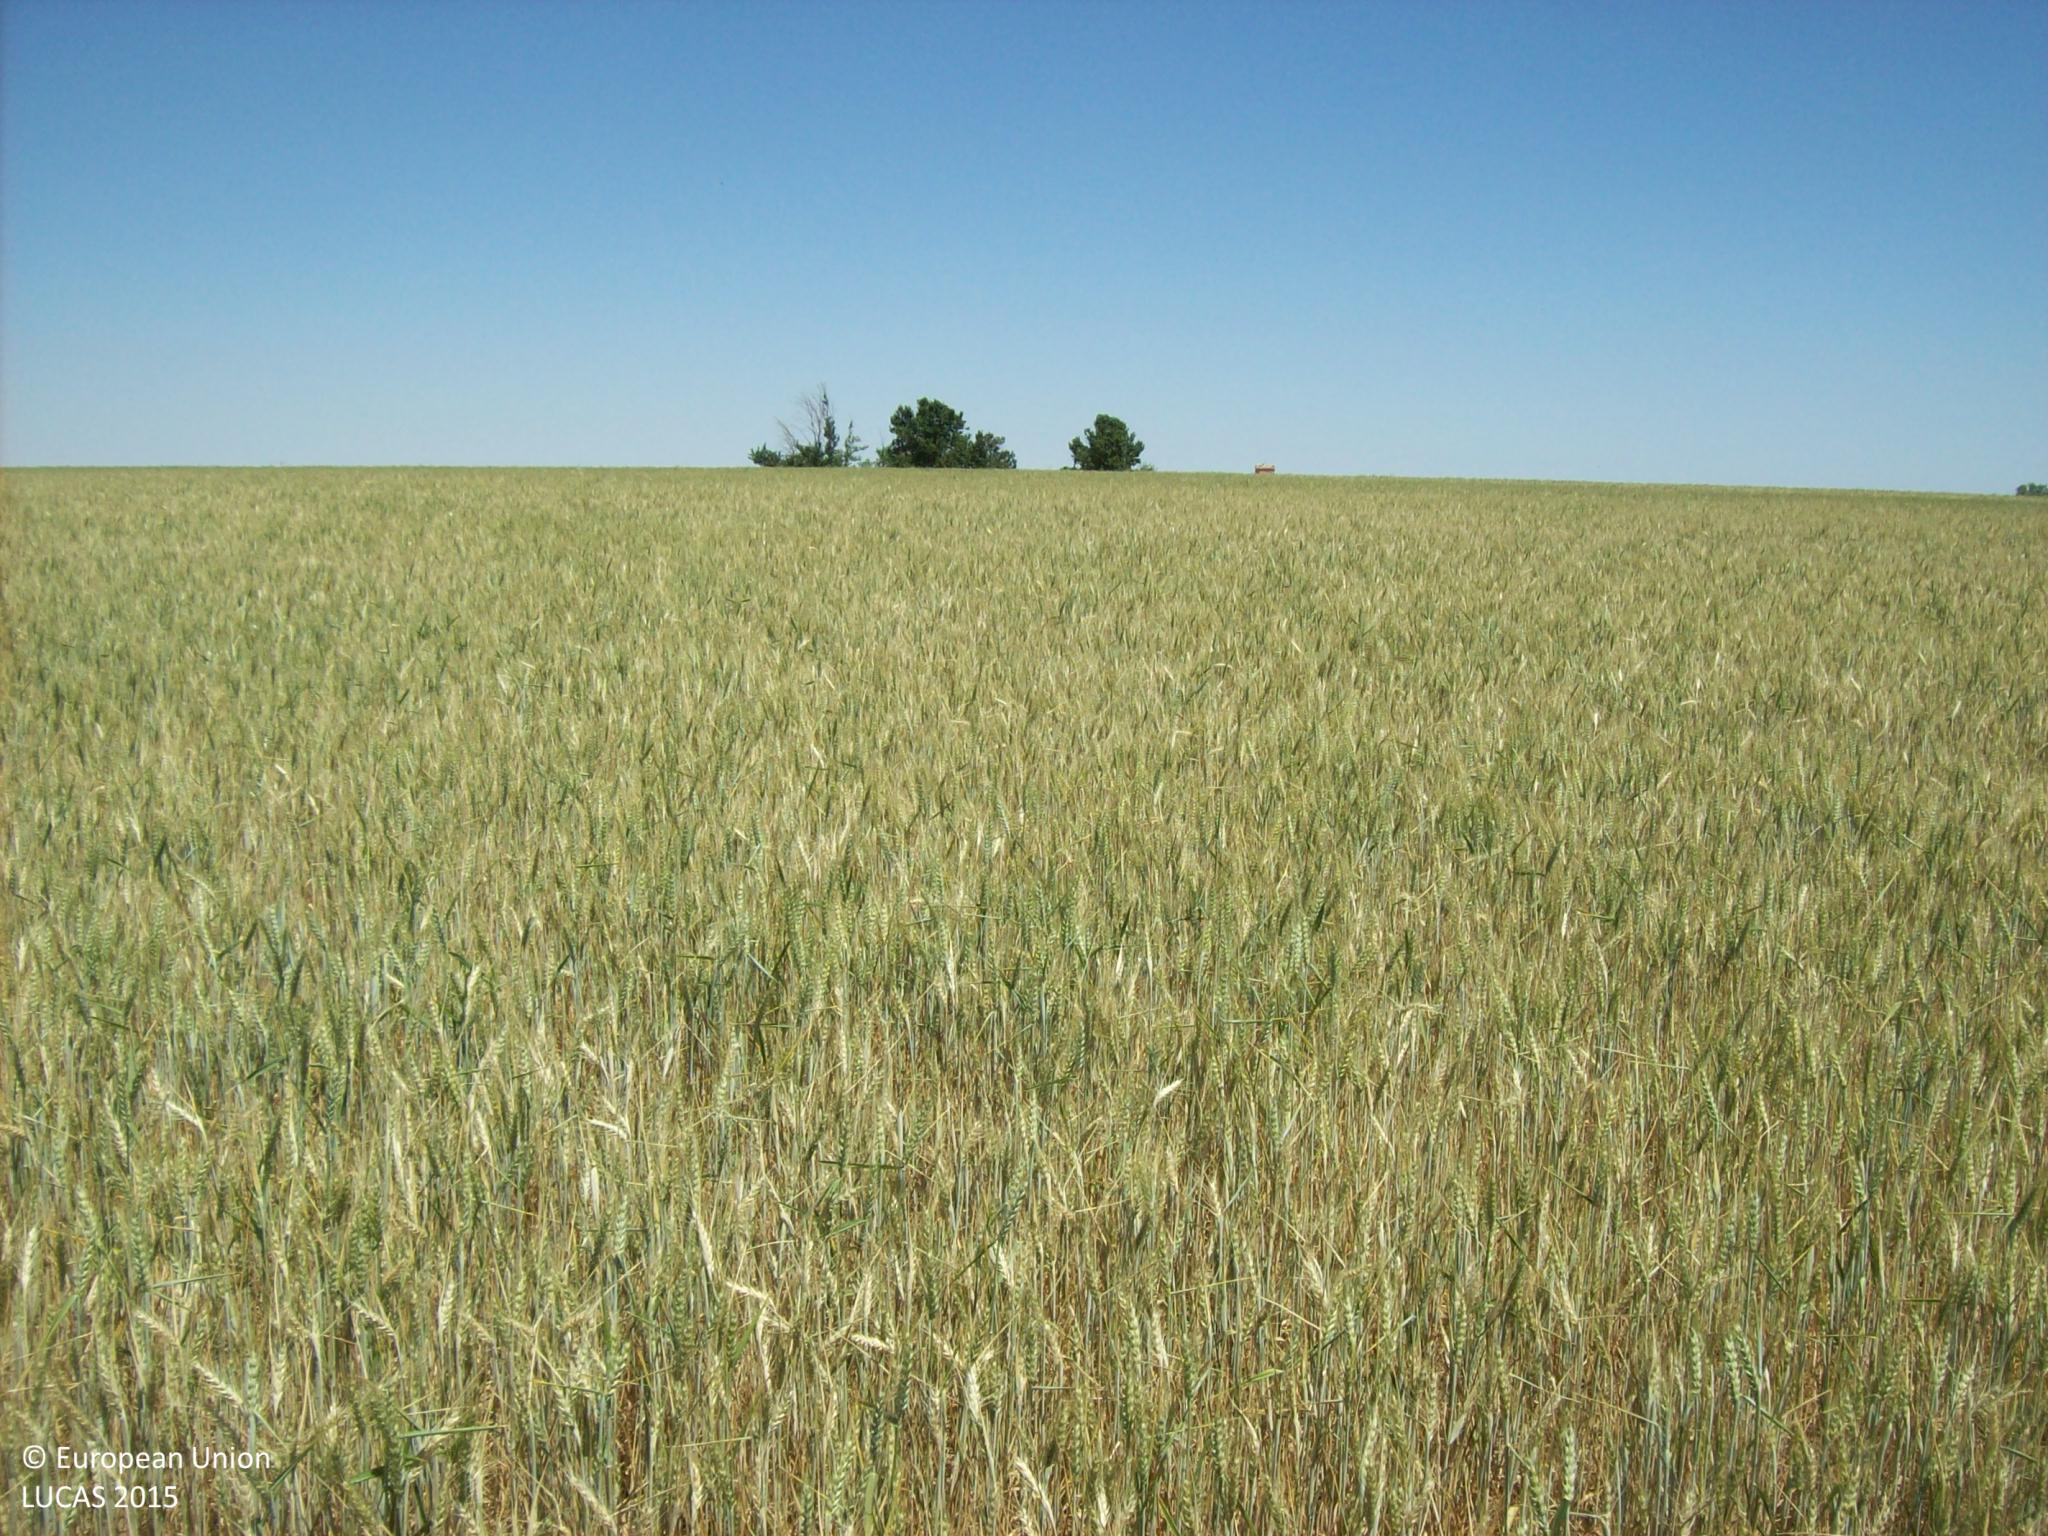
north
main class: Cropland
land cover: Common wheat
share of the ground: > 75 %
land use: Agriculture (excluding fallow land and kitchen gardens)
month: May
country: ES
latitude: 40.8797
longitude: -4.9318
